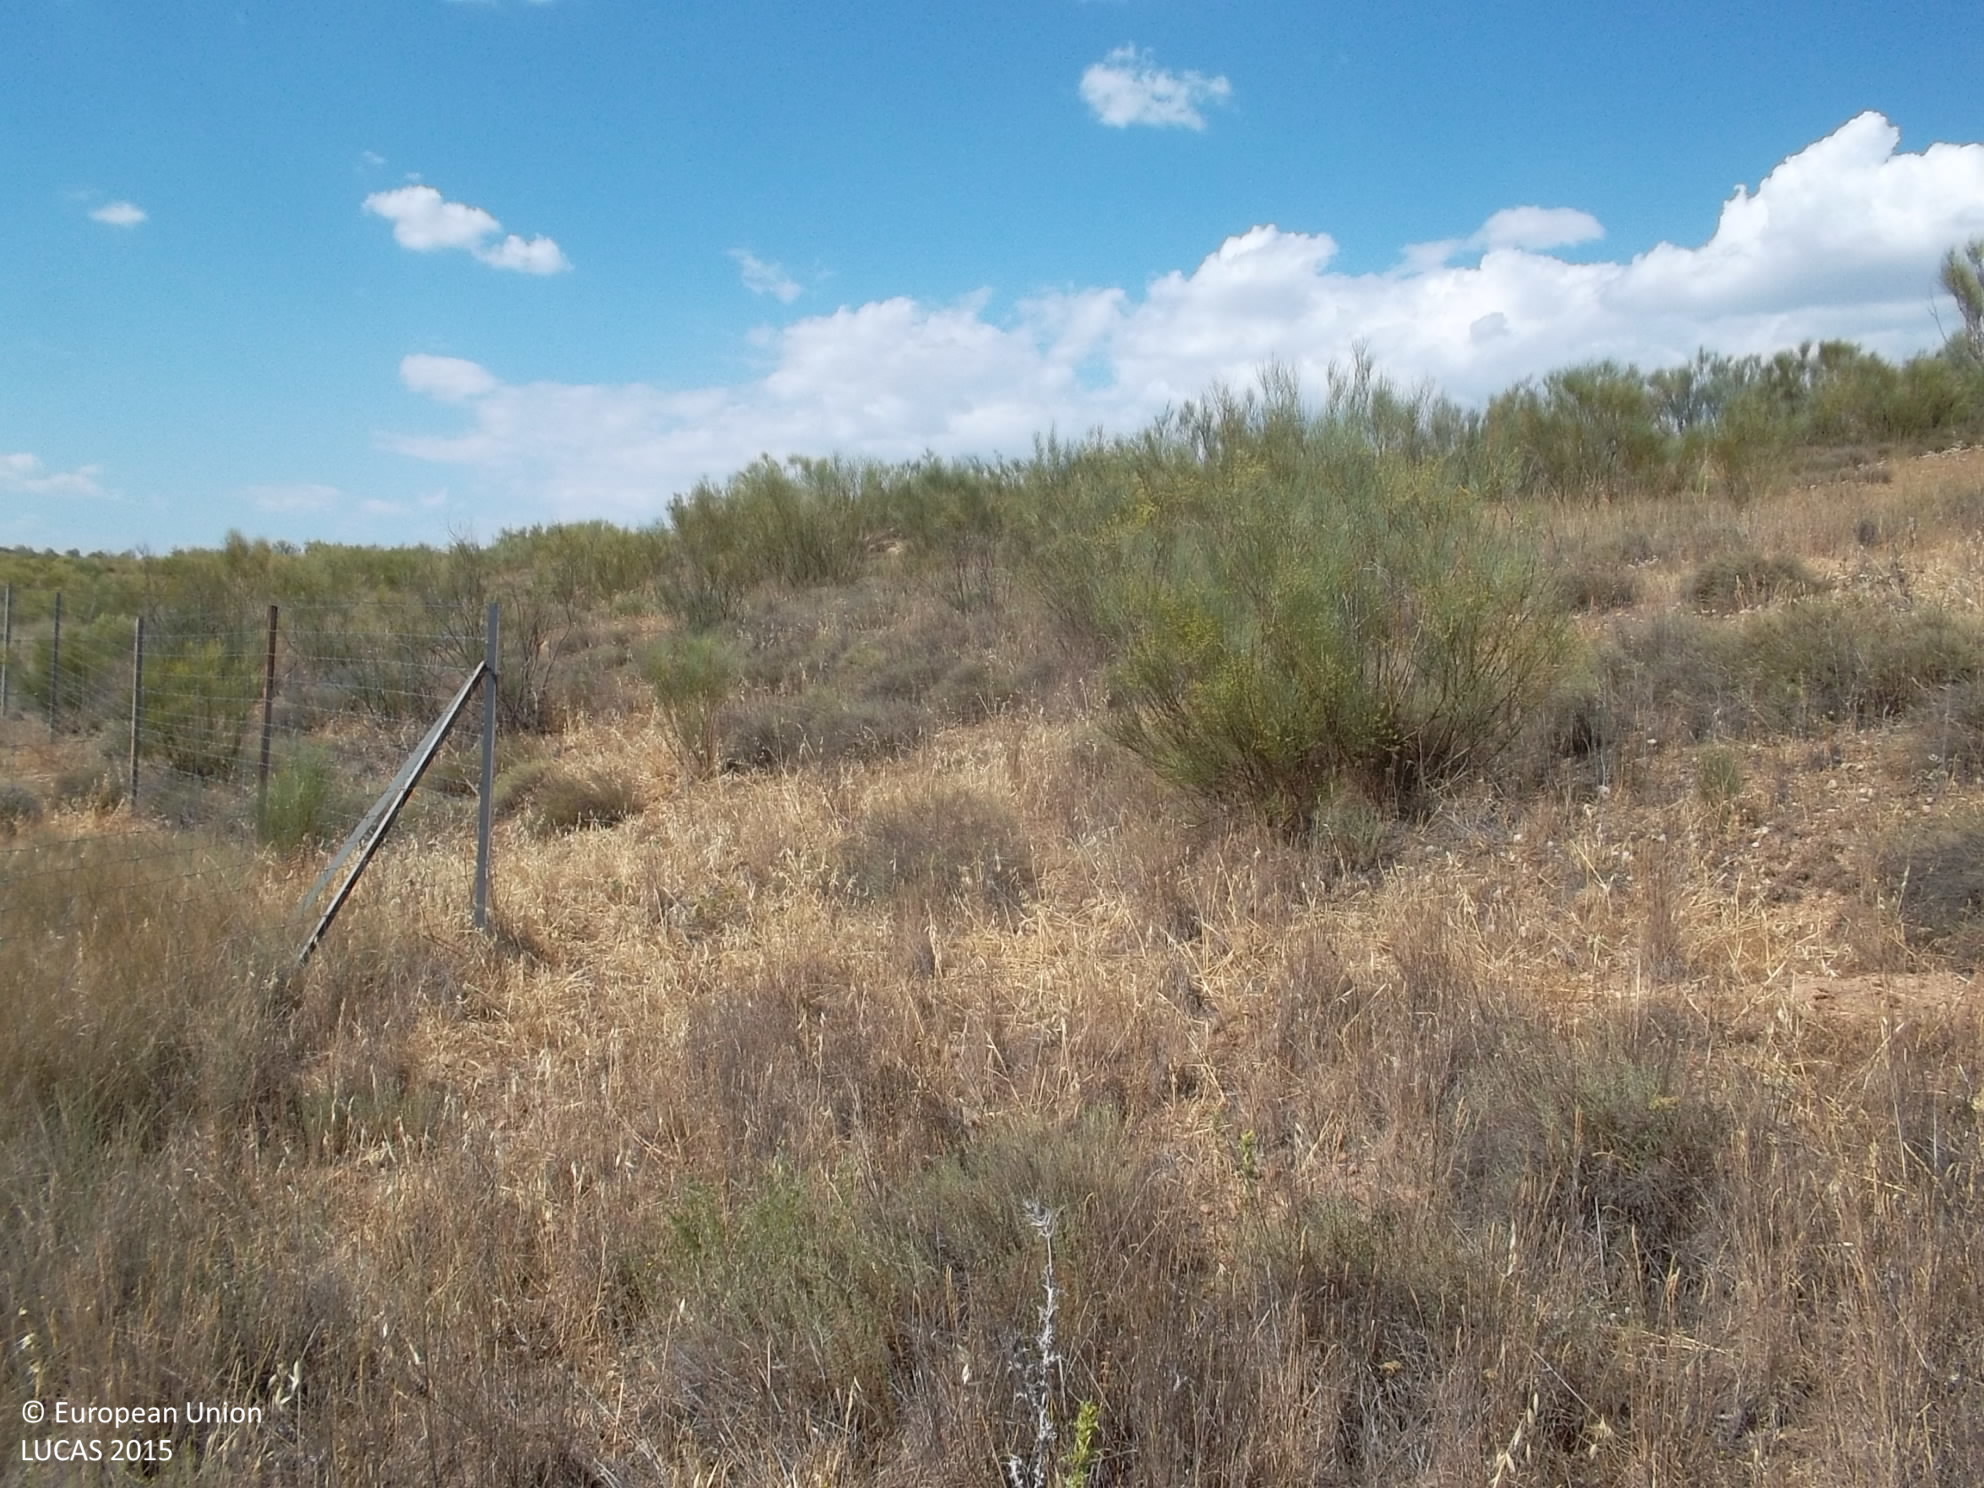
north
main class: Grassland
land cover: Grassland with sparse tree/shrub cover
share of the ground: > 75 %
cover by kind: herbaceous plants 85 %, shrubs 10 %, broadleaved forest trees 5 %
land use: Agriculture (excluding fallow land and kitchen gardens)
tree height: < 5 m
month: June
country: ES
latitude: 37.6847
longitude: -3.2041
